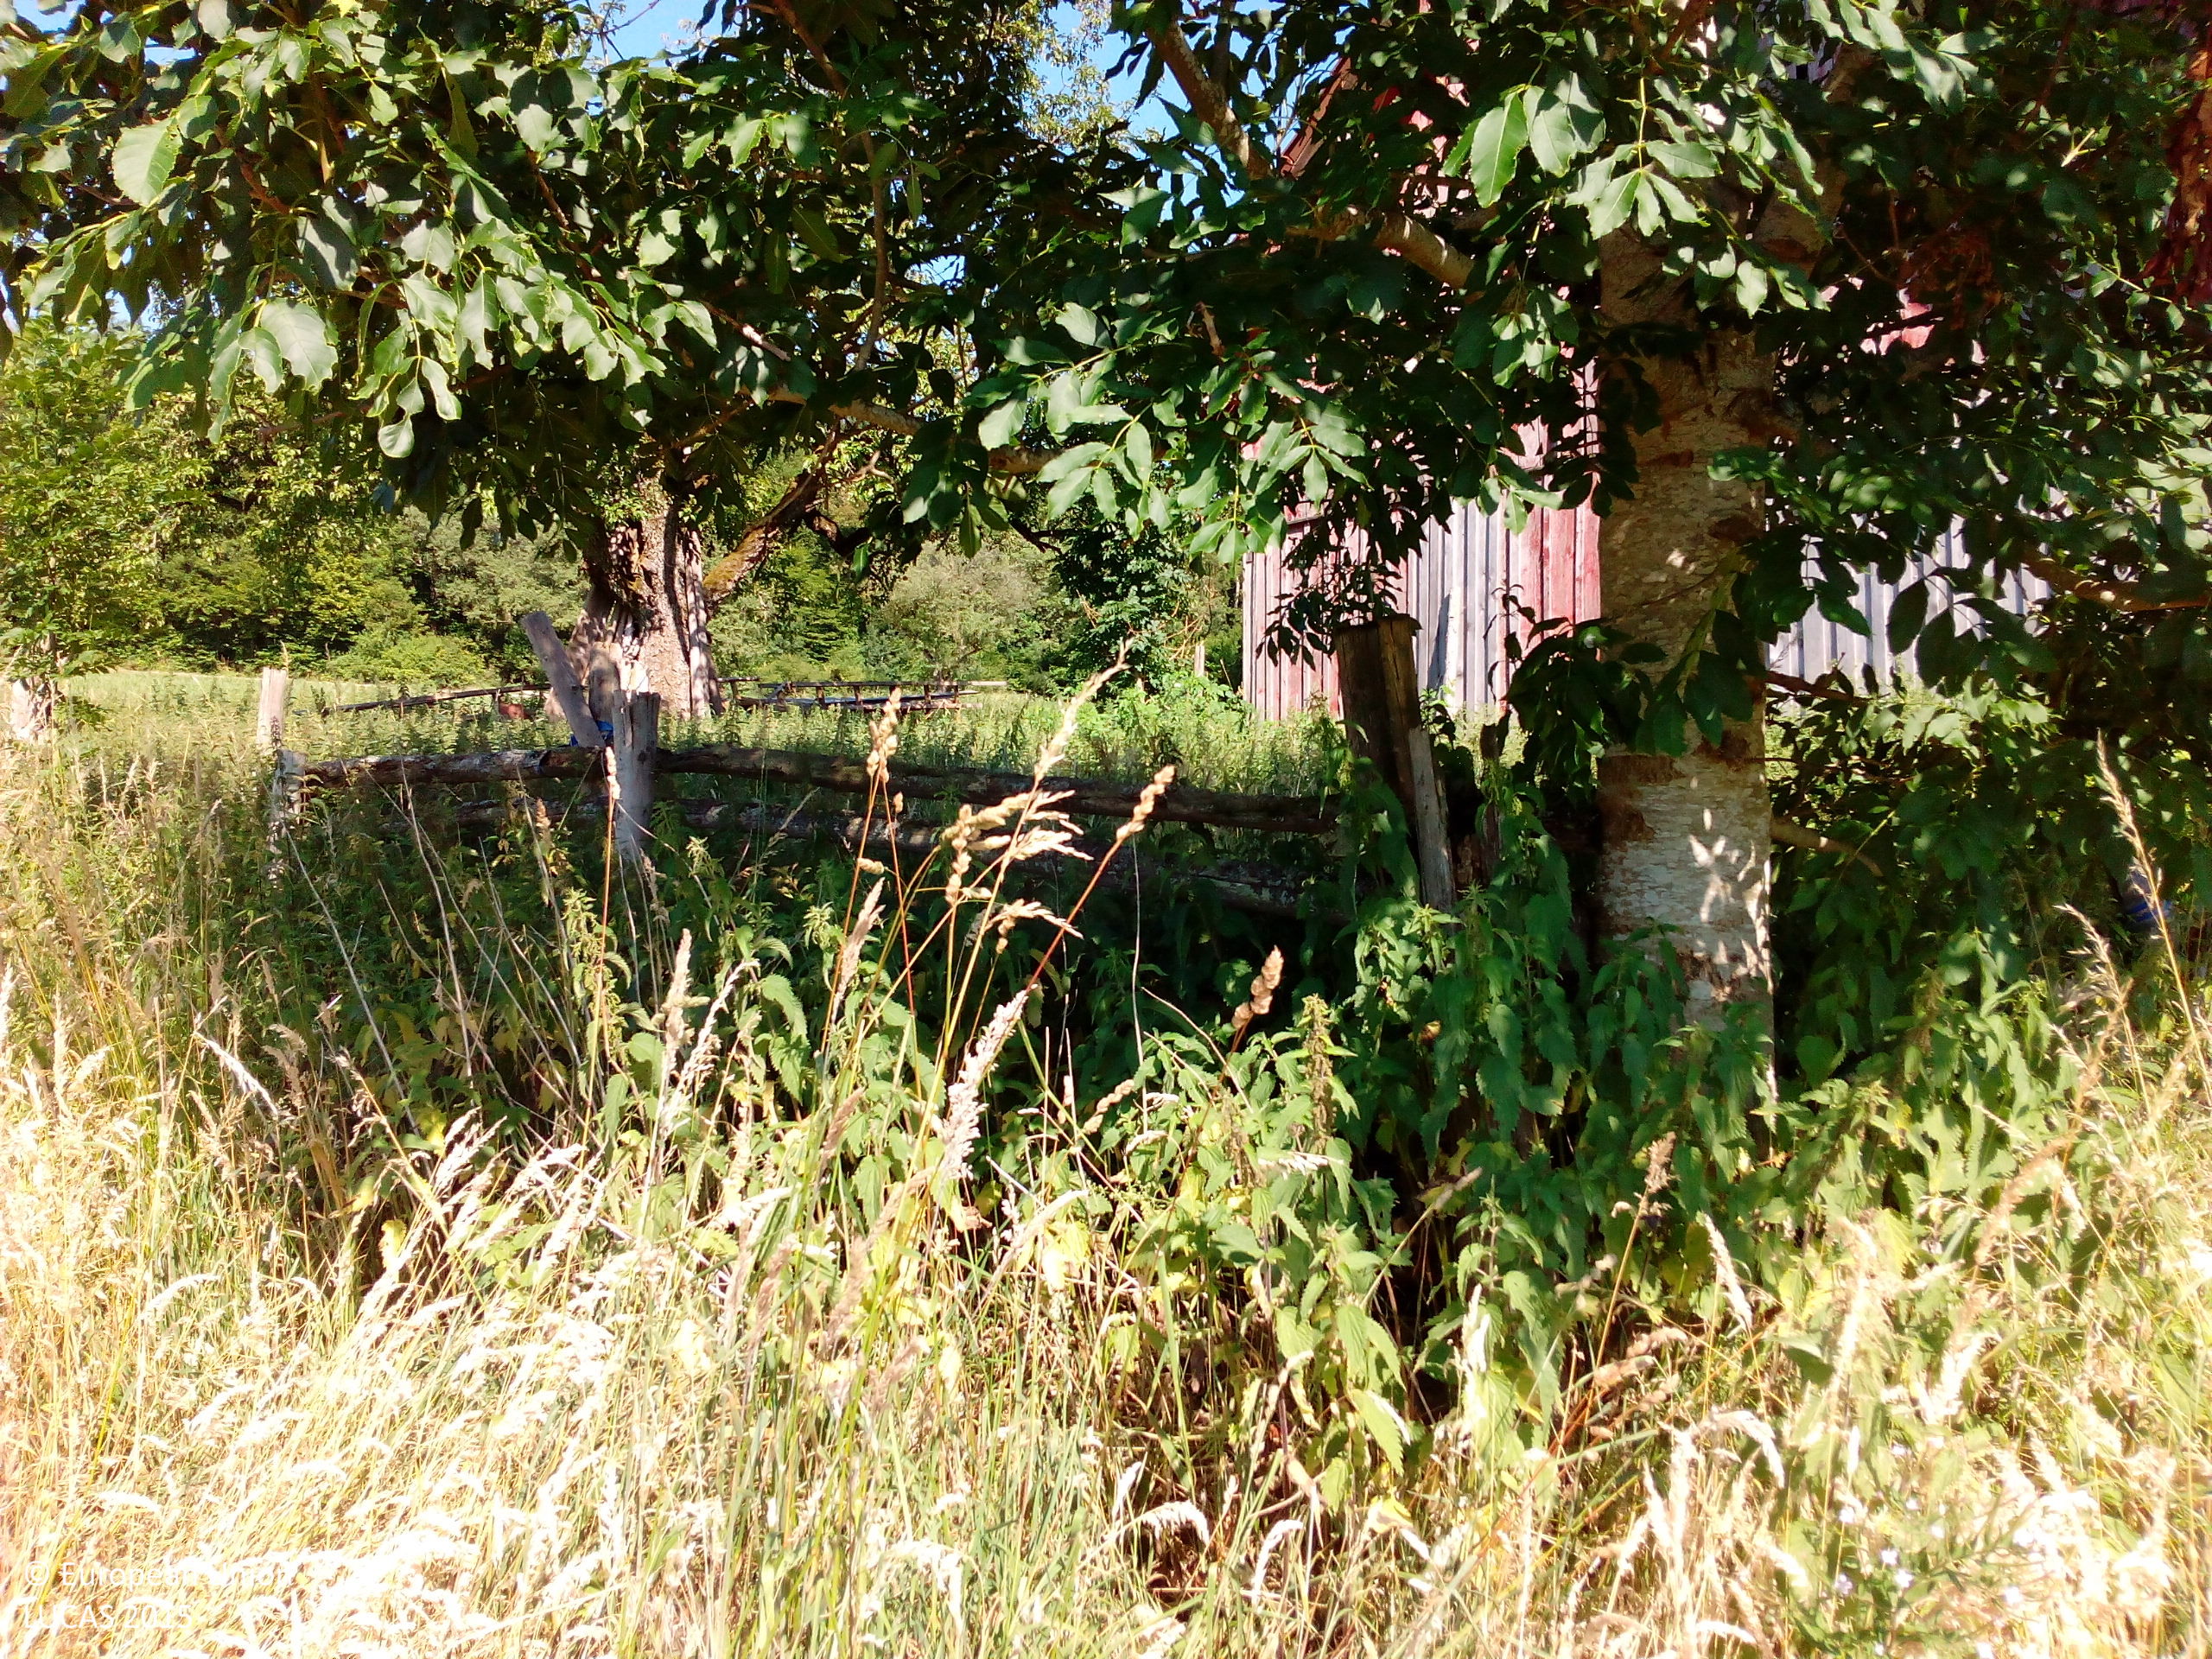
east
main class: Cropland
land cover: Maize
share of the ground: 25 - 50 %
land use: Agriculture (excluding fallow land and kitchen gardens)
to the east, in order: Maize; Other bare soil; Tracks; Broadleaved woodland; Tracks; Broadleaved woodland; Ditches and canals; Tracks; Broadleaved woodland; Tracks; Broadleaved woodland
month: July
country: DE
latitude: 47.7843
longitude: 8.7329
